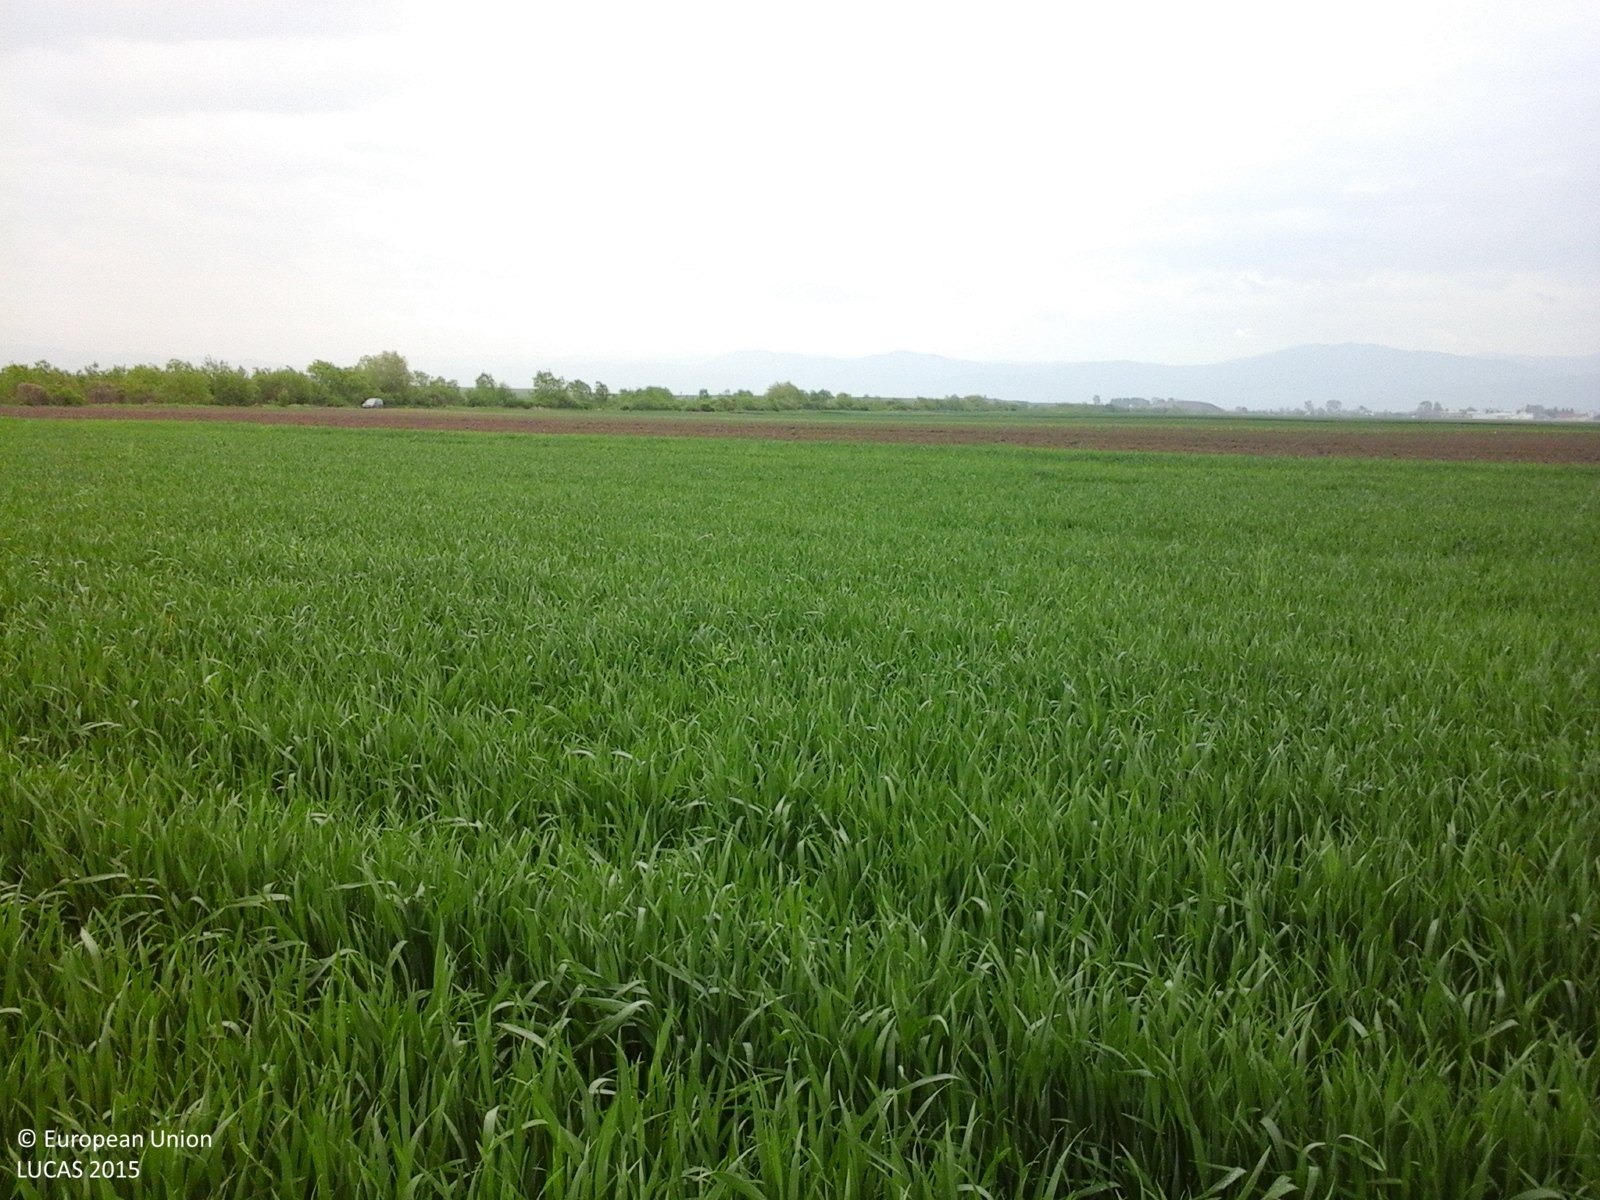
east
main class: Cropland
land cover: Common wheat
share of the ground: > 75 %
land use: Fallow land
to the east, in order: Common wheat; Potatoes; Maize; Other fresh vegetables
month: May
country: RO
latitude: 46.0209
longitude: 26.0984
